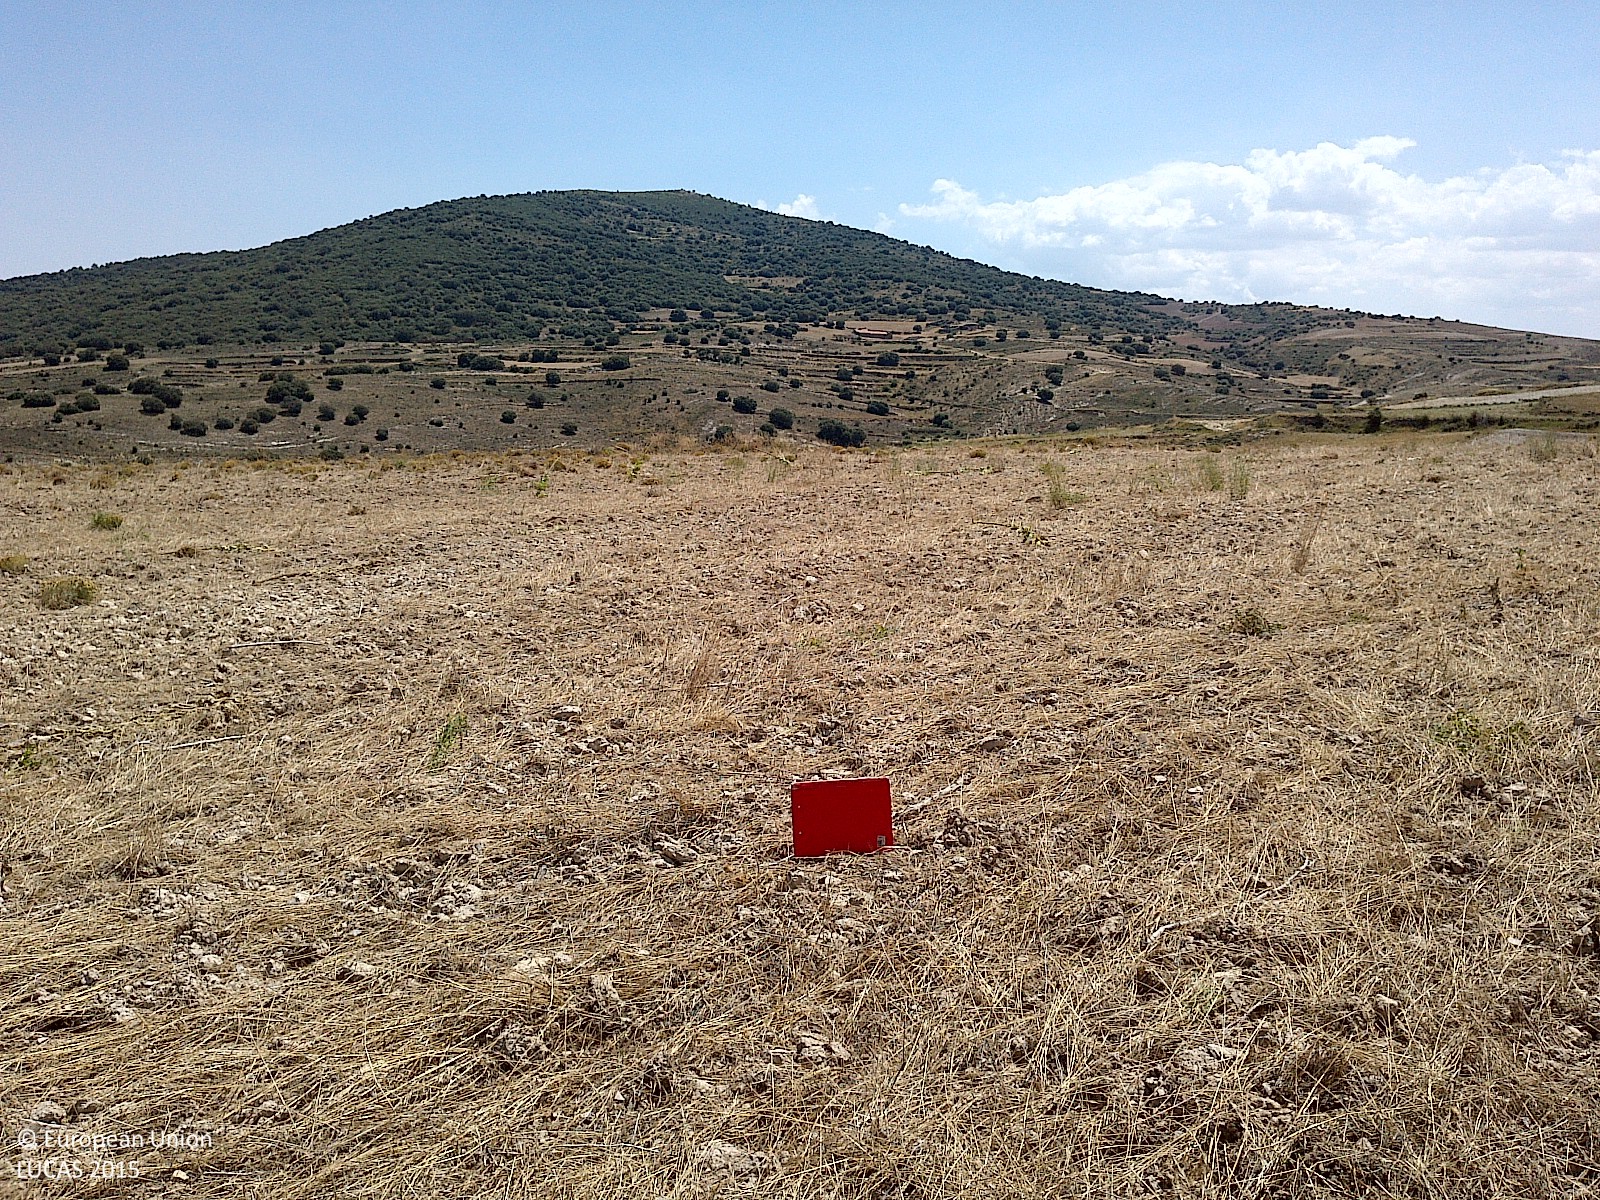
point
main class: Grassland
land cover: Spontaneously vegetated surfaces
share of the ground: 25 - 50 %
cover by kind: unconsolidated bare surface 70 %, herbaceous plants 30 %
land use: Fallow land
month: July
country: ES
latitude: 41.9158
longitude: -2.0314
